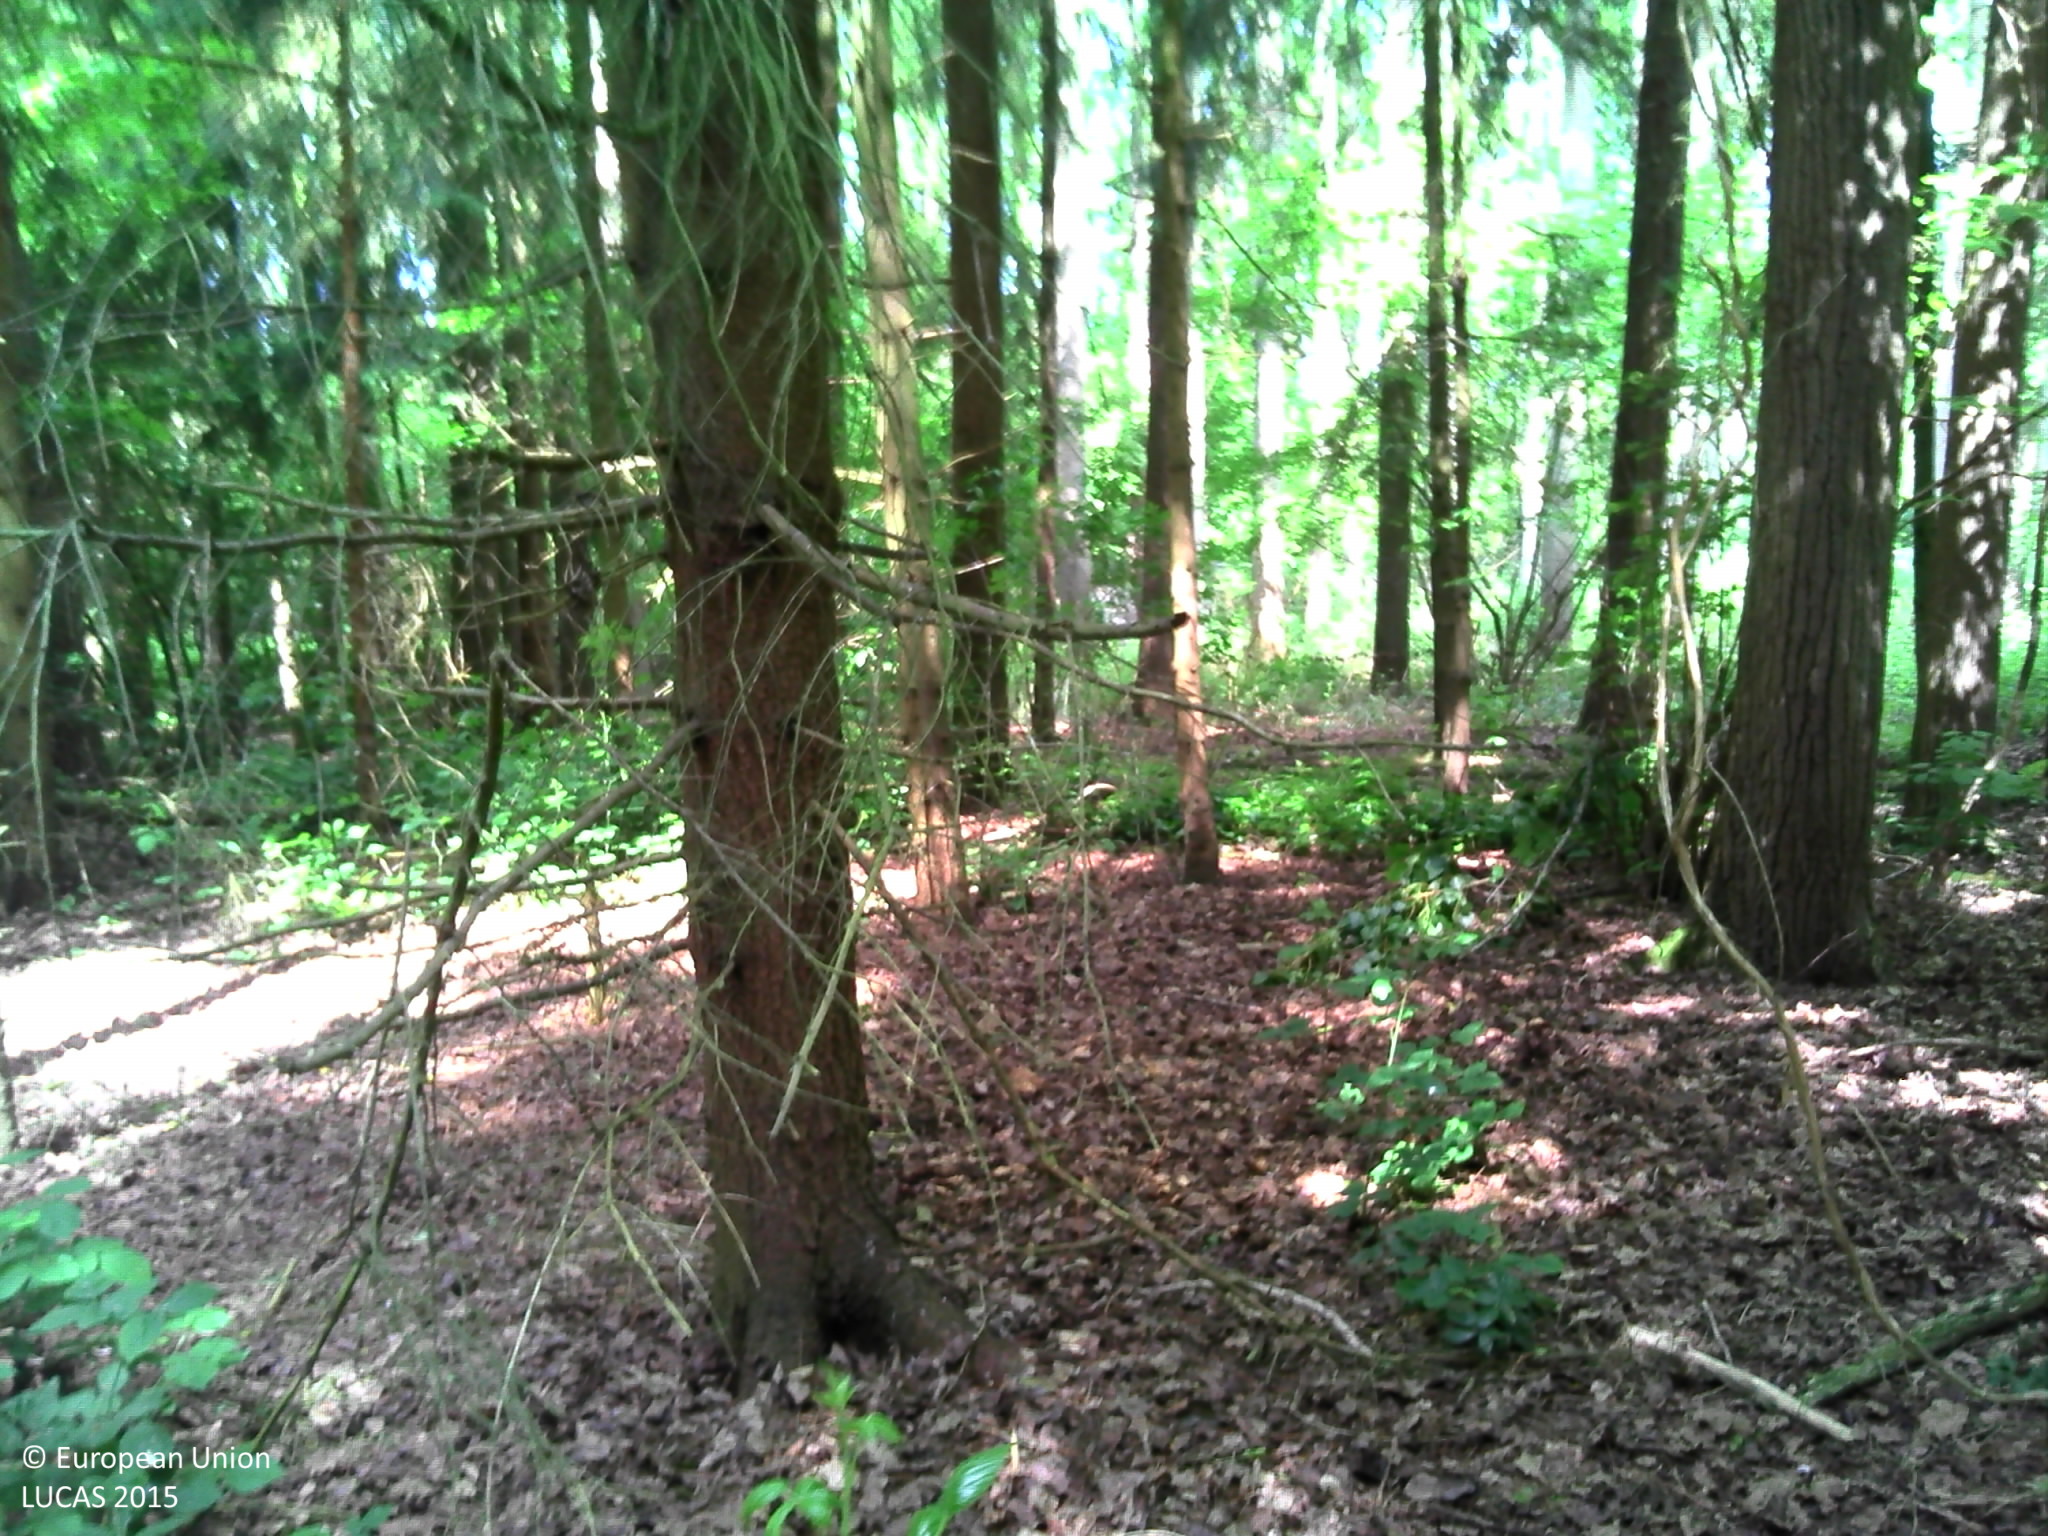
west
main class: Woodland
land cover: Spruce dominated coniferous woodland
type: hemiboreal forest and nemoral coniferous forest and mixed broadleaved-coniferous forest
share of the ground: > 75 %
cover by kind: coniferous forest trees 100 %
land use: Forestry
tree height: > 5 m
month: June
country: BE
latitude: 50.9400
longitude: 3.8885
